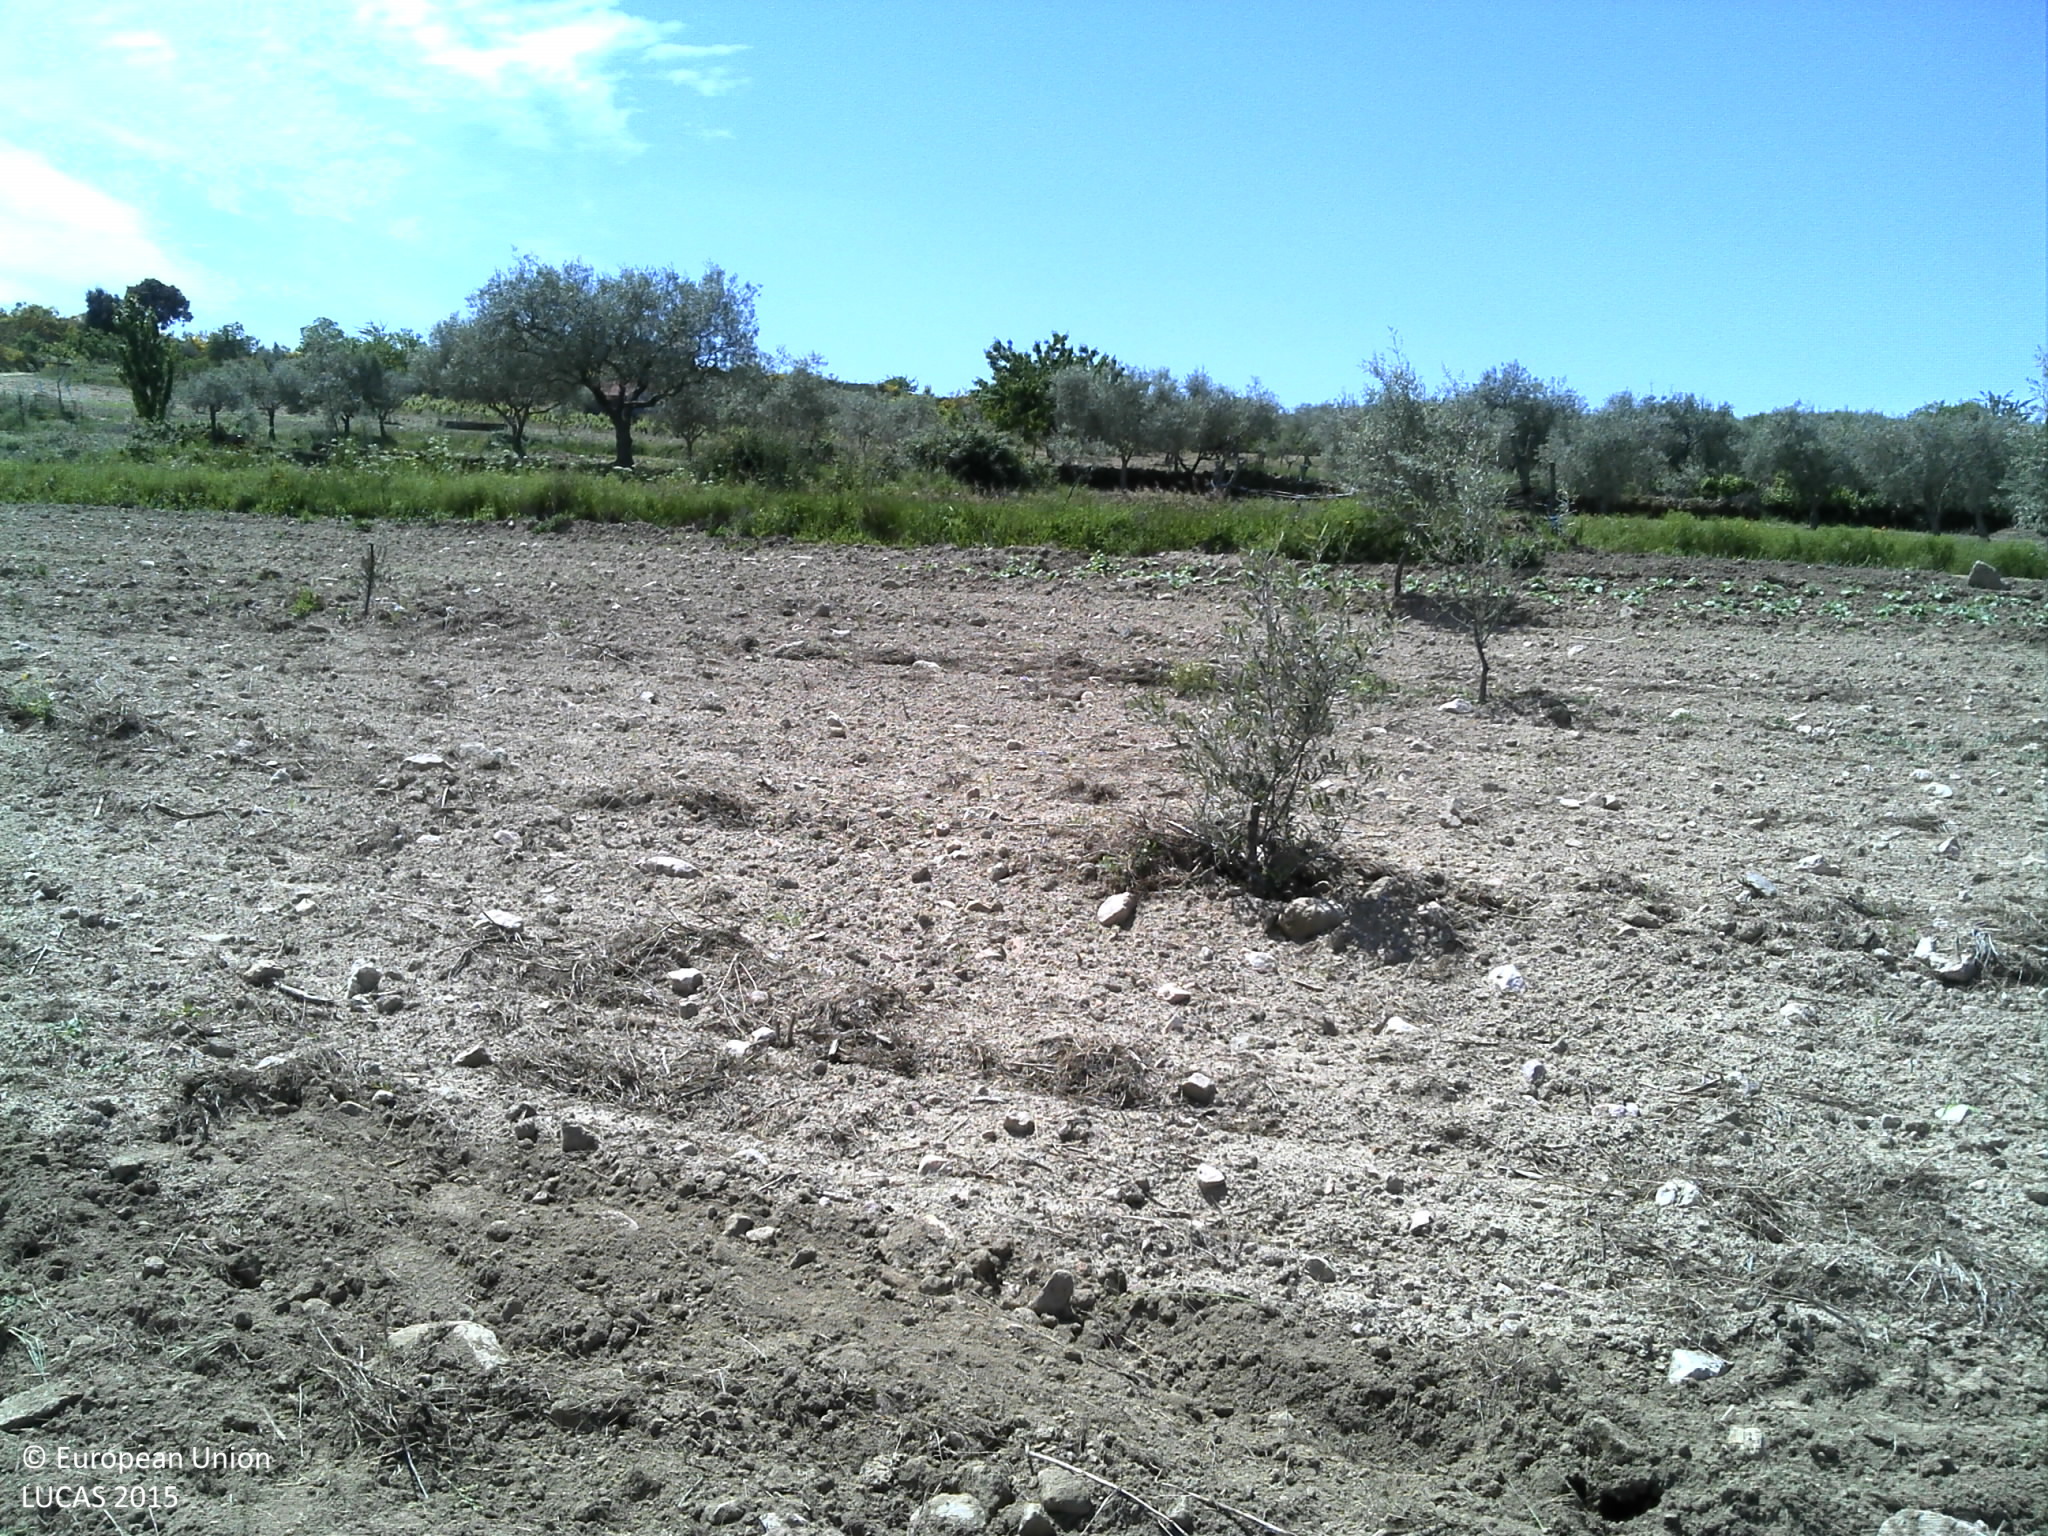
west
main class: Cropland
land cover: Olive groves
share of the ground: < 10 %
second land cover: Spontaneously vegetated surfaces
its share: < 10 %
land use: Agriculture (excluding fallow land and kitchen gardens)
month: May
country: PT
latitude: 41.7069
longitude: -7.0767
